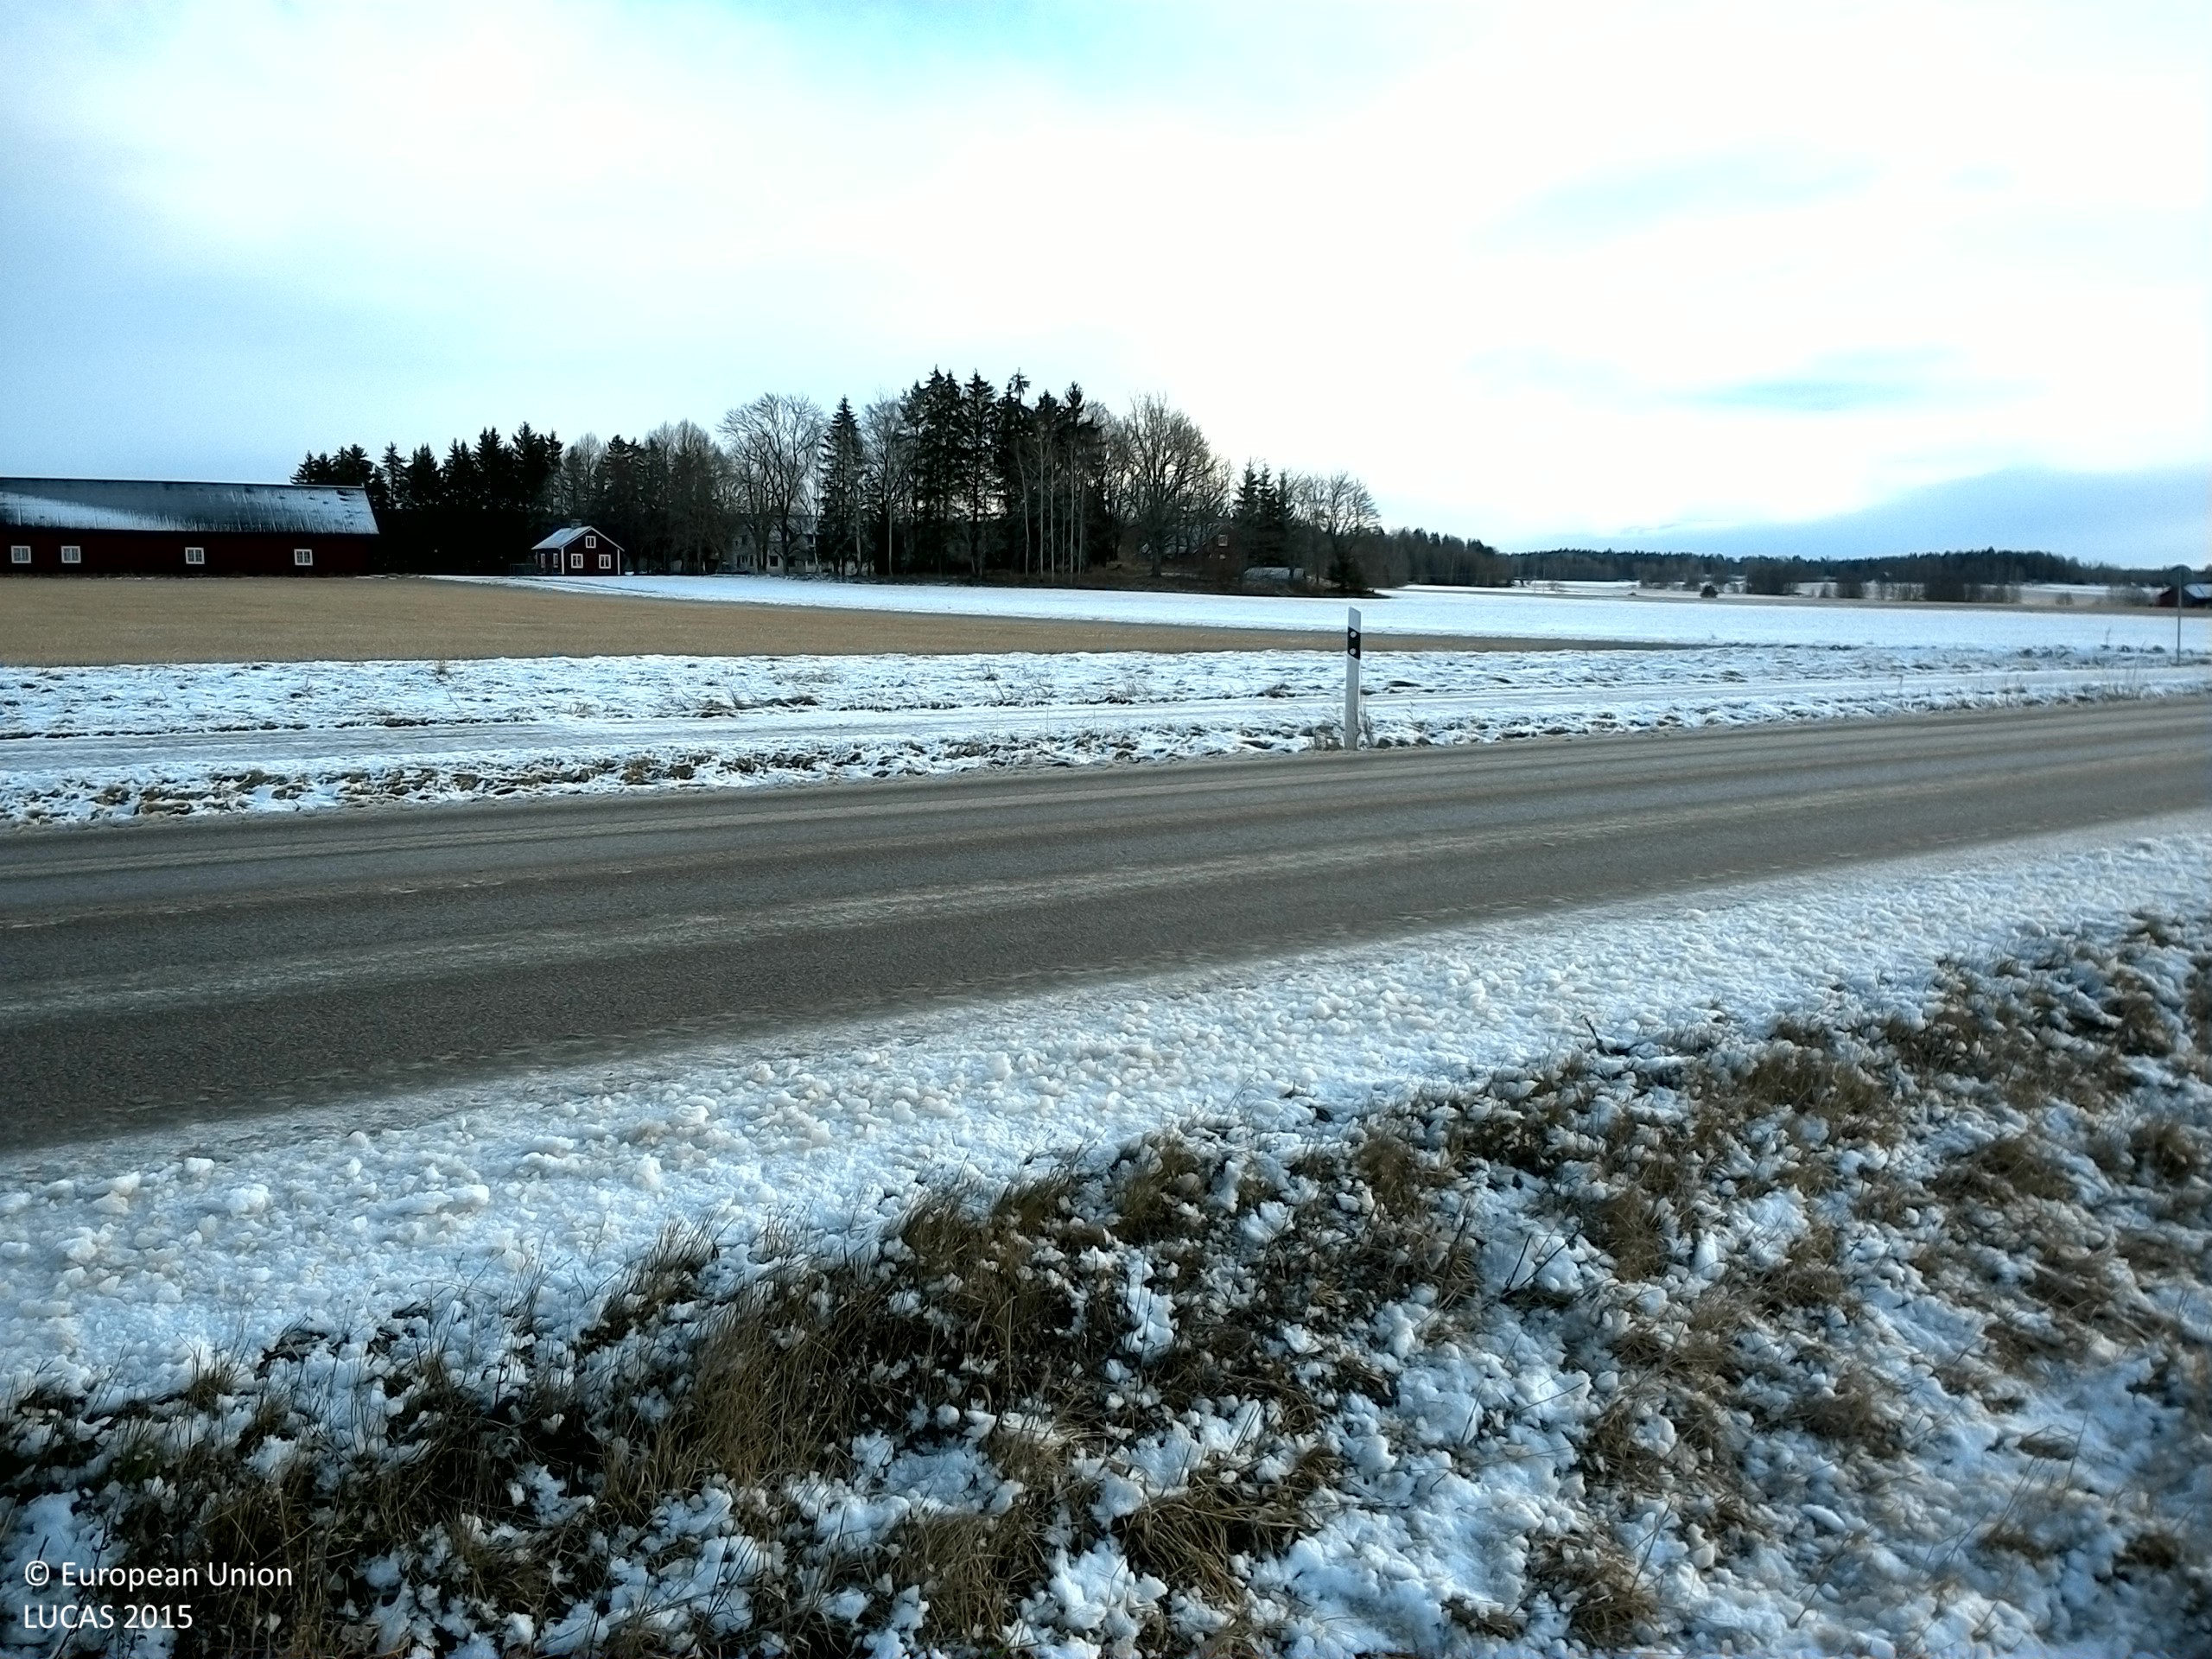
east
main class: Cropland
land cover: Common wheat
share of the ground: 10 - 25 %
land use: Agriculture (excluding fallow land and kitchen gardens)
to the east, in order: Common wheat; Grass margins; Ditches and canals; Grass margins; Paved roads, cycling and walking lanes; Grass margins; Ditches and canals; Tracks; Grassland without tree/shrub cover; Other bare soil; Ditches and canals; Grass margins
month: December
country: SE
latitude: 59.6903
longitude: 16.4401
